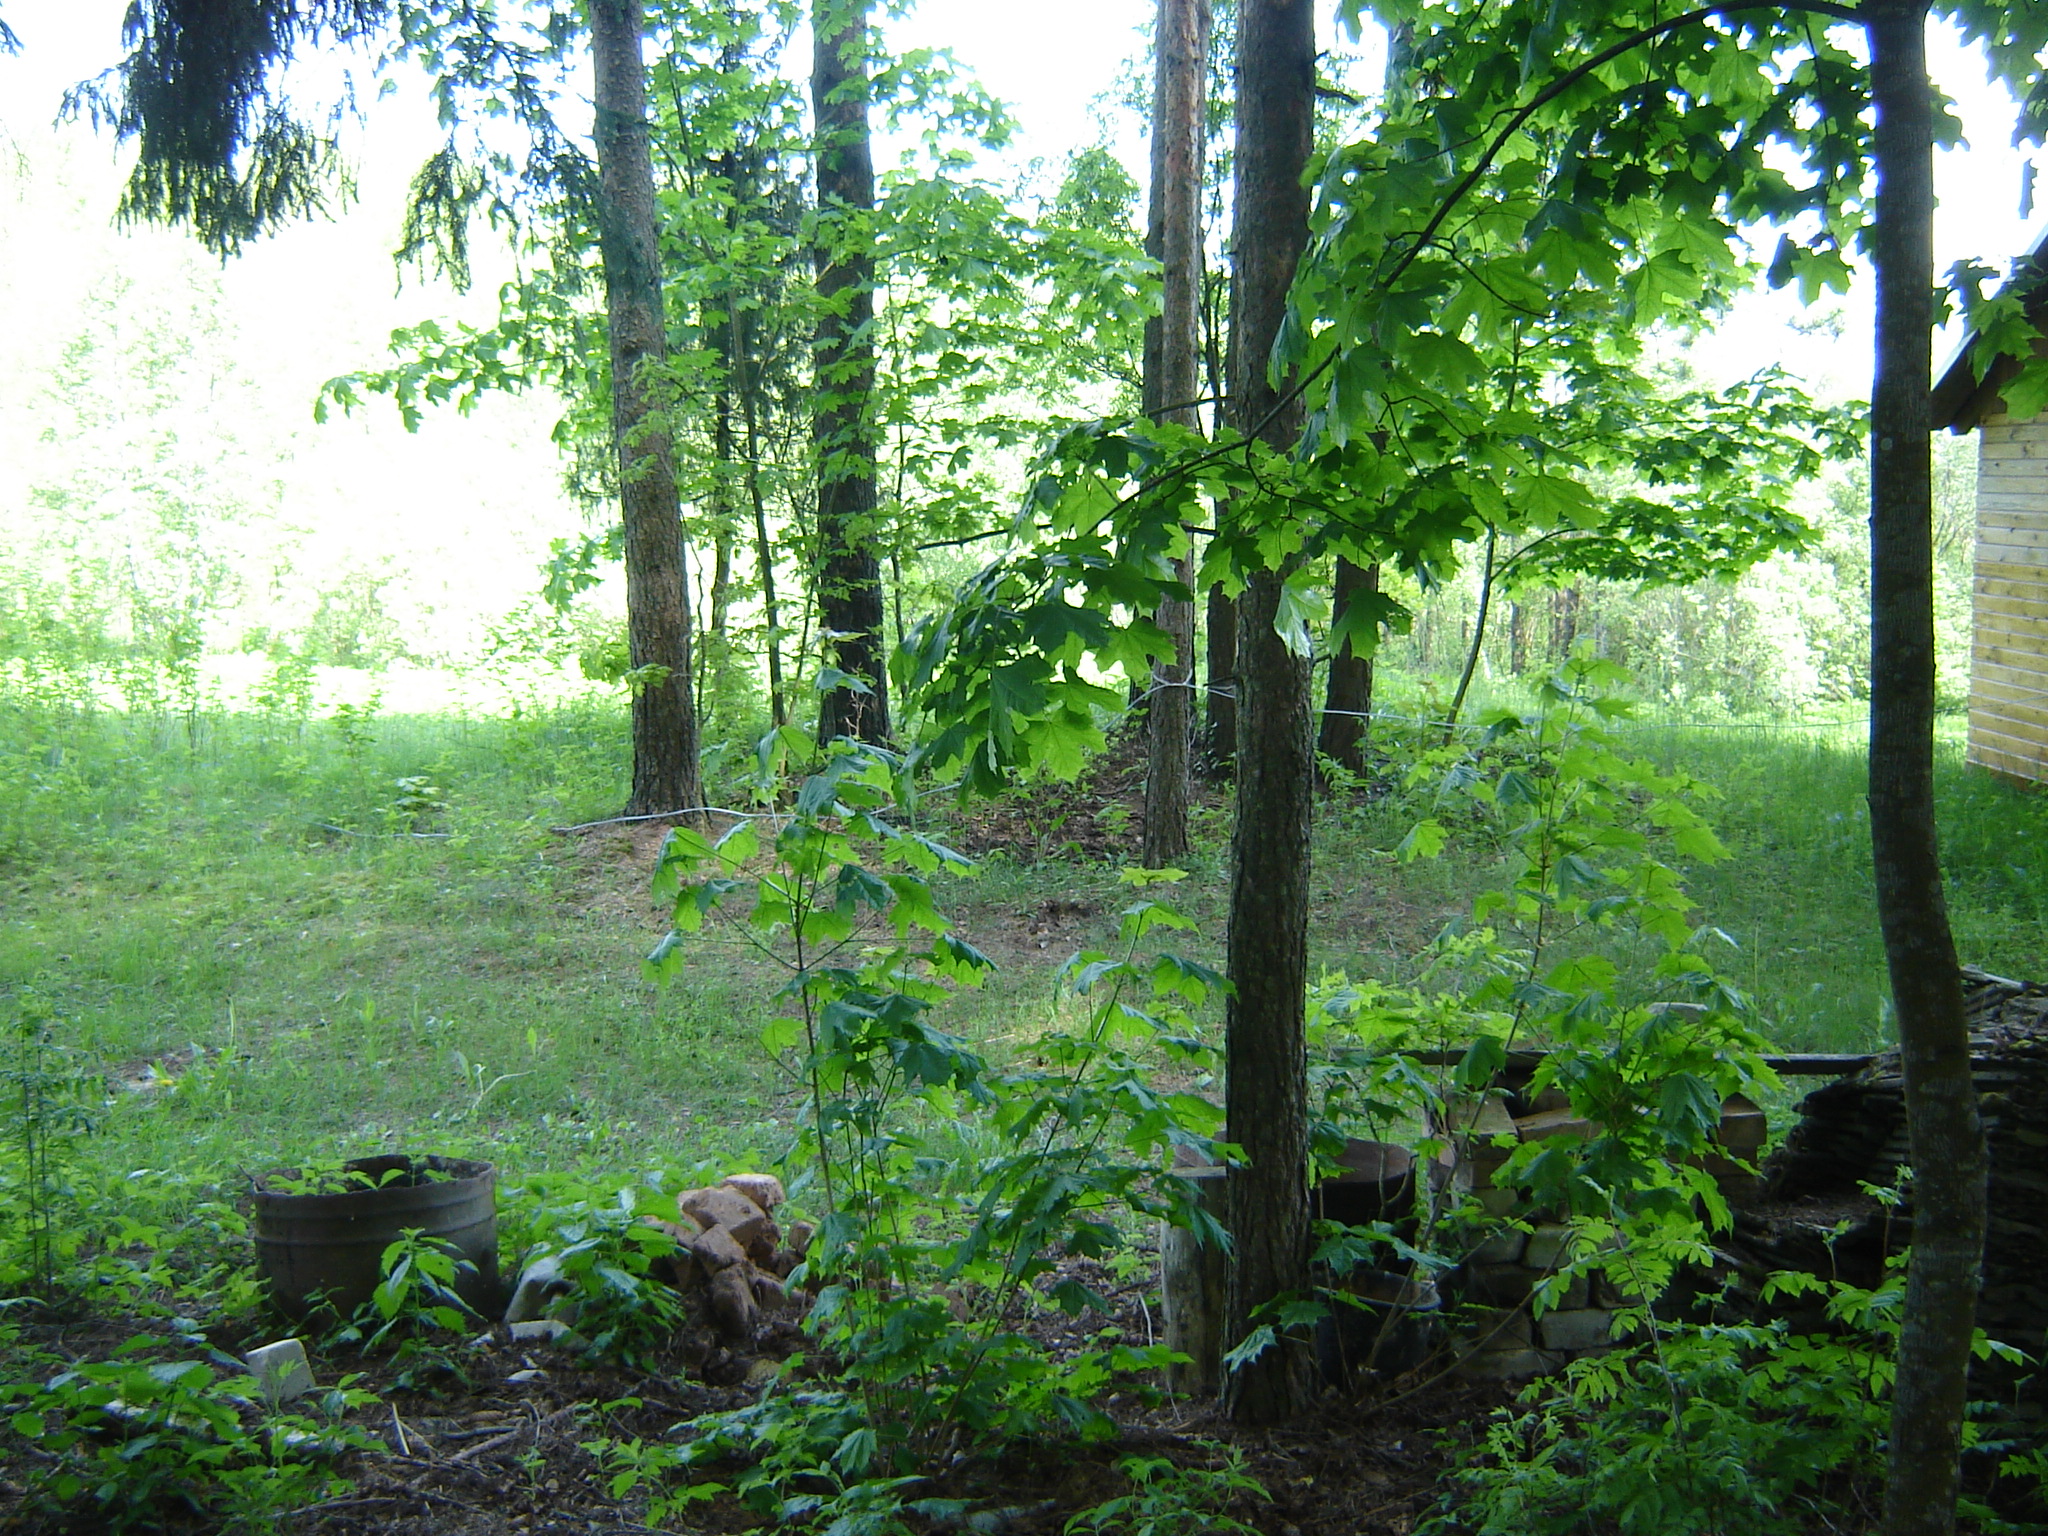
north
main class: Woodland
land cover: Other mixed woodland
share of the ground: > 75 %
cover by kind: coniferous forest trees 55 %, broadleaved forest trees 30 %, unconsolidated bare surface 10 %, herbaceous plants 5 %
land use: Forestry
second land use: Residential
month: May
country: LT
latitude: 55.7181
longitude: 25.3215
